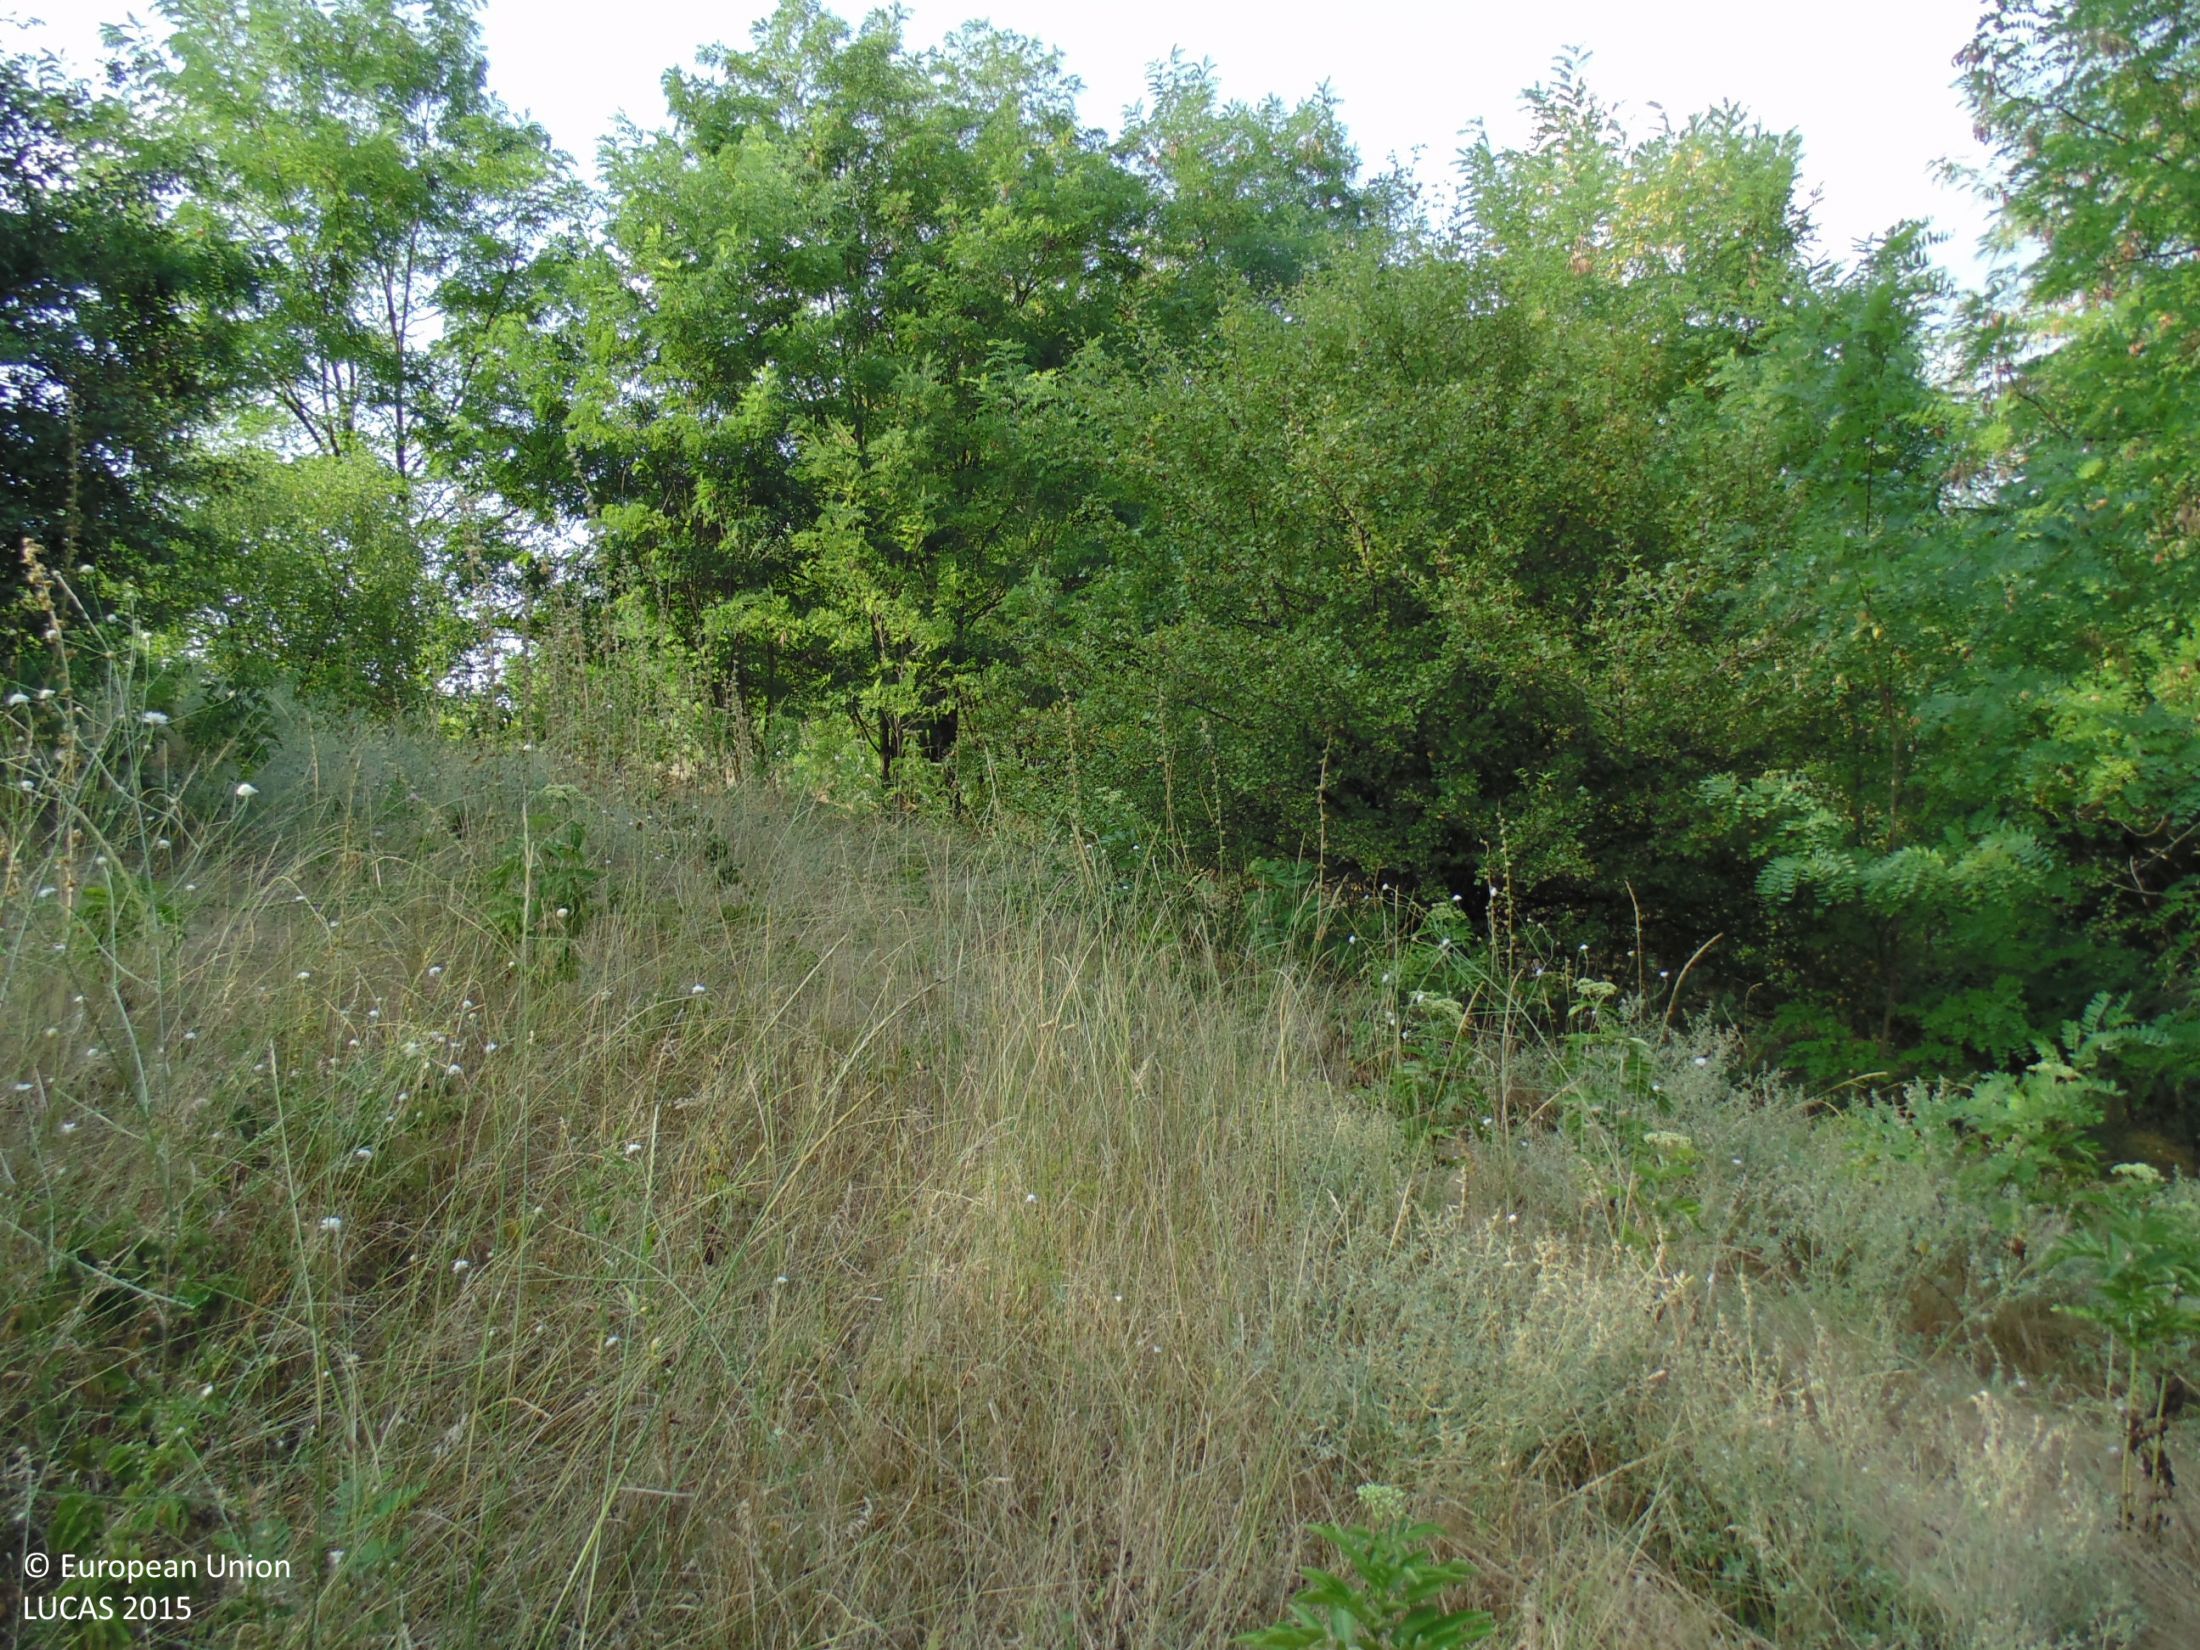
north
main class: Woodland
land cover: Broadleaved woodland
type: mesophytic deciduous forest
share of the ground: 50 - 75 %
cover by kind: broadleaved forest trees 70 %, shrubs 15 %, herbaceous plants 15 %
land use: Semi-natural and natural areas not in use
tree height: > 5 m
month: August
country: BG
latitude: 43.9392
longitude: 27.6956
